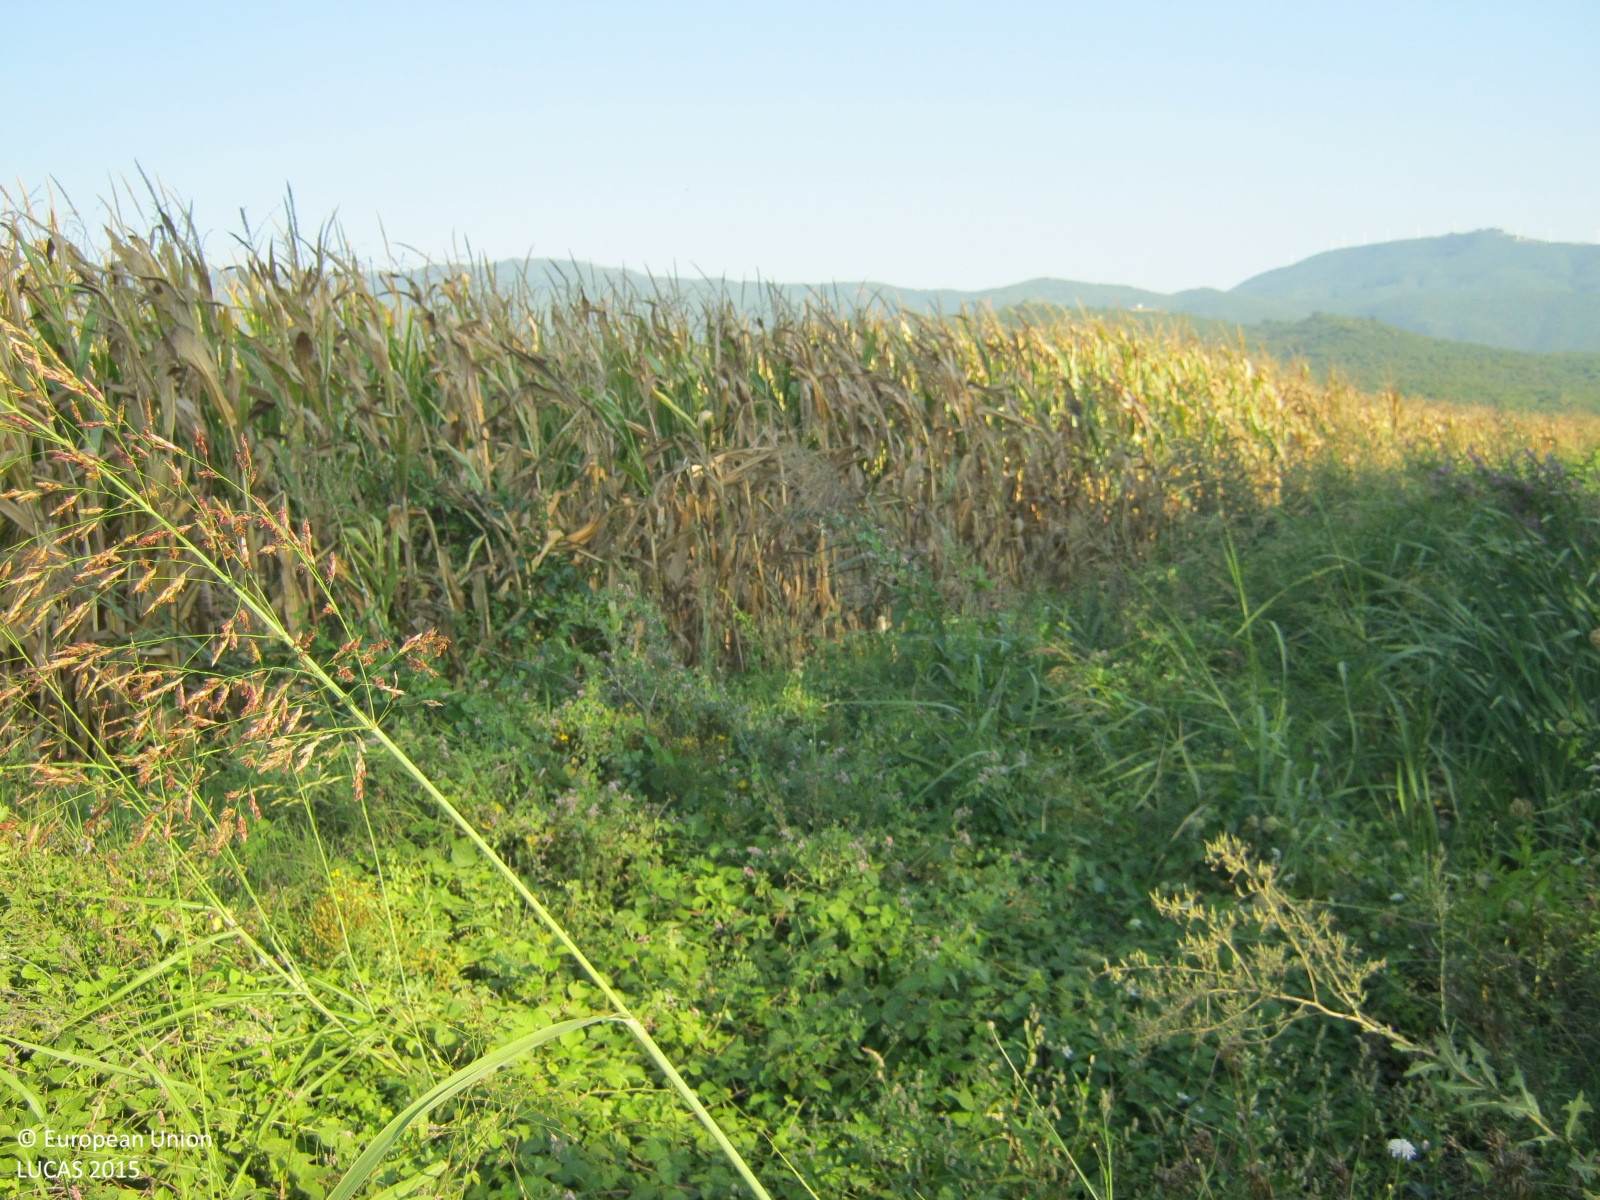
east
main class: Cropland
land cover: Maize
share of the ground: > 75 %
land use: Agriculture (excluding fallow land and kitchen gardens)
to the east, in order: Maize; Abandoned hedges; Maize; Abandoned hedges
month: August
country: GR
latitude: 41.3636
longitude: 23.3497
